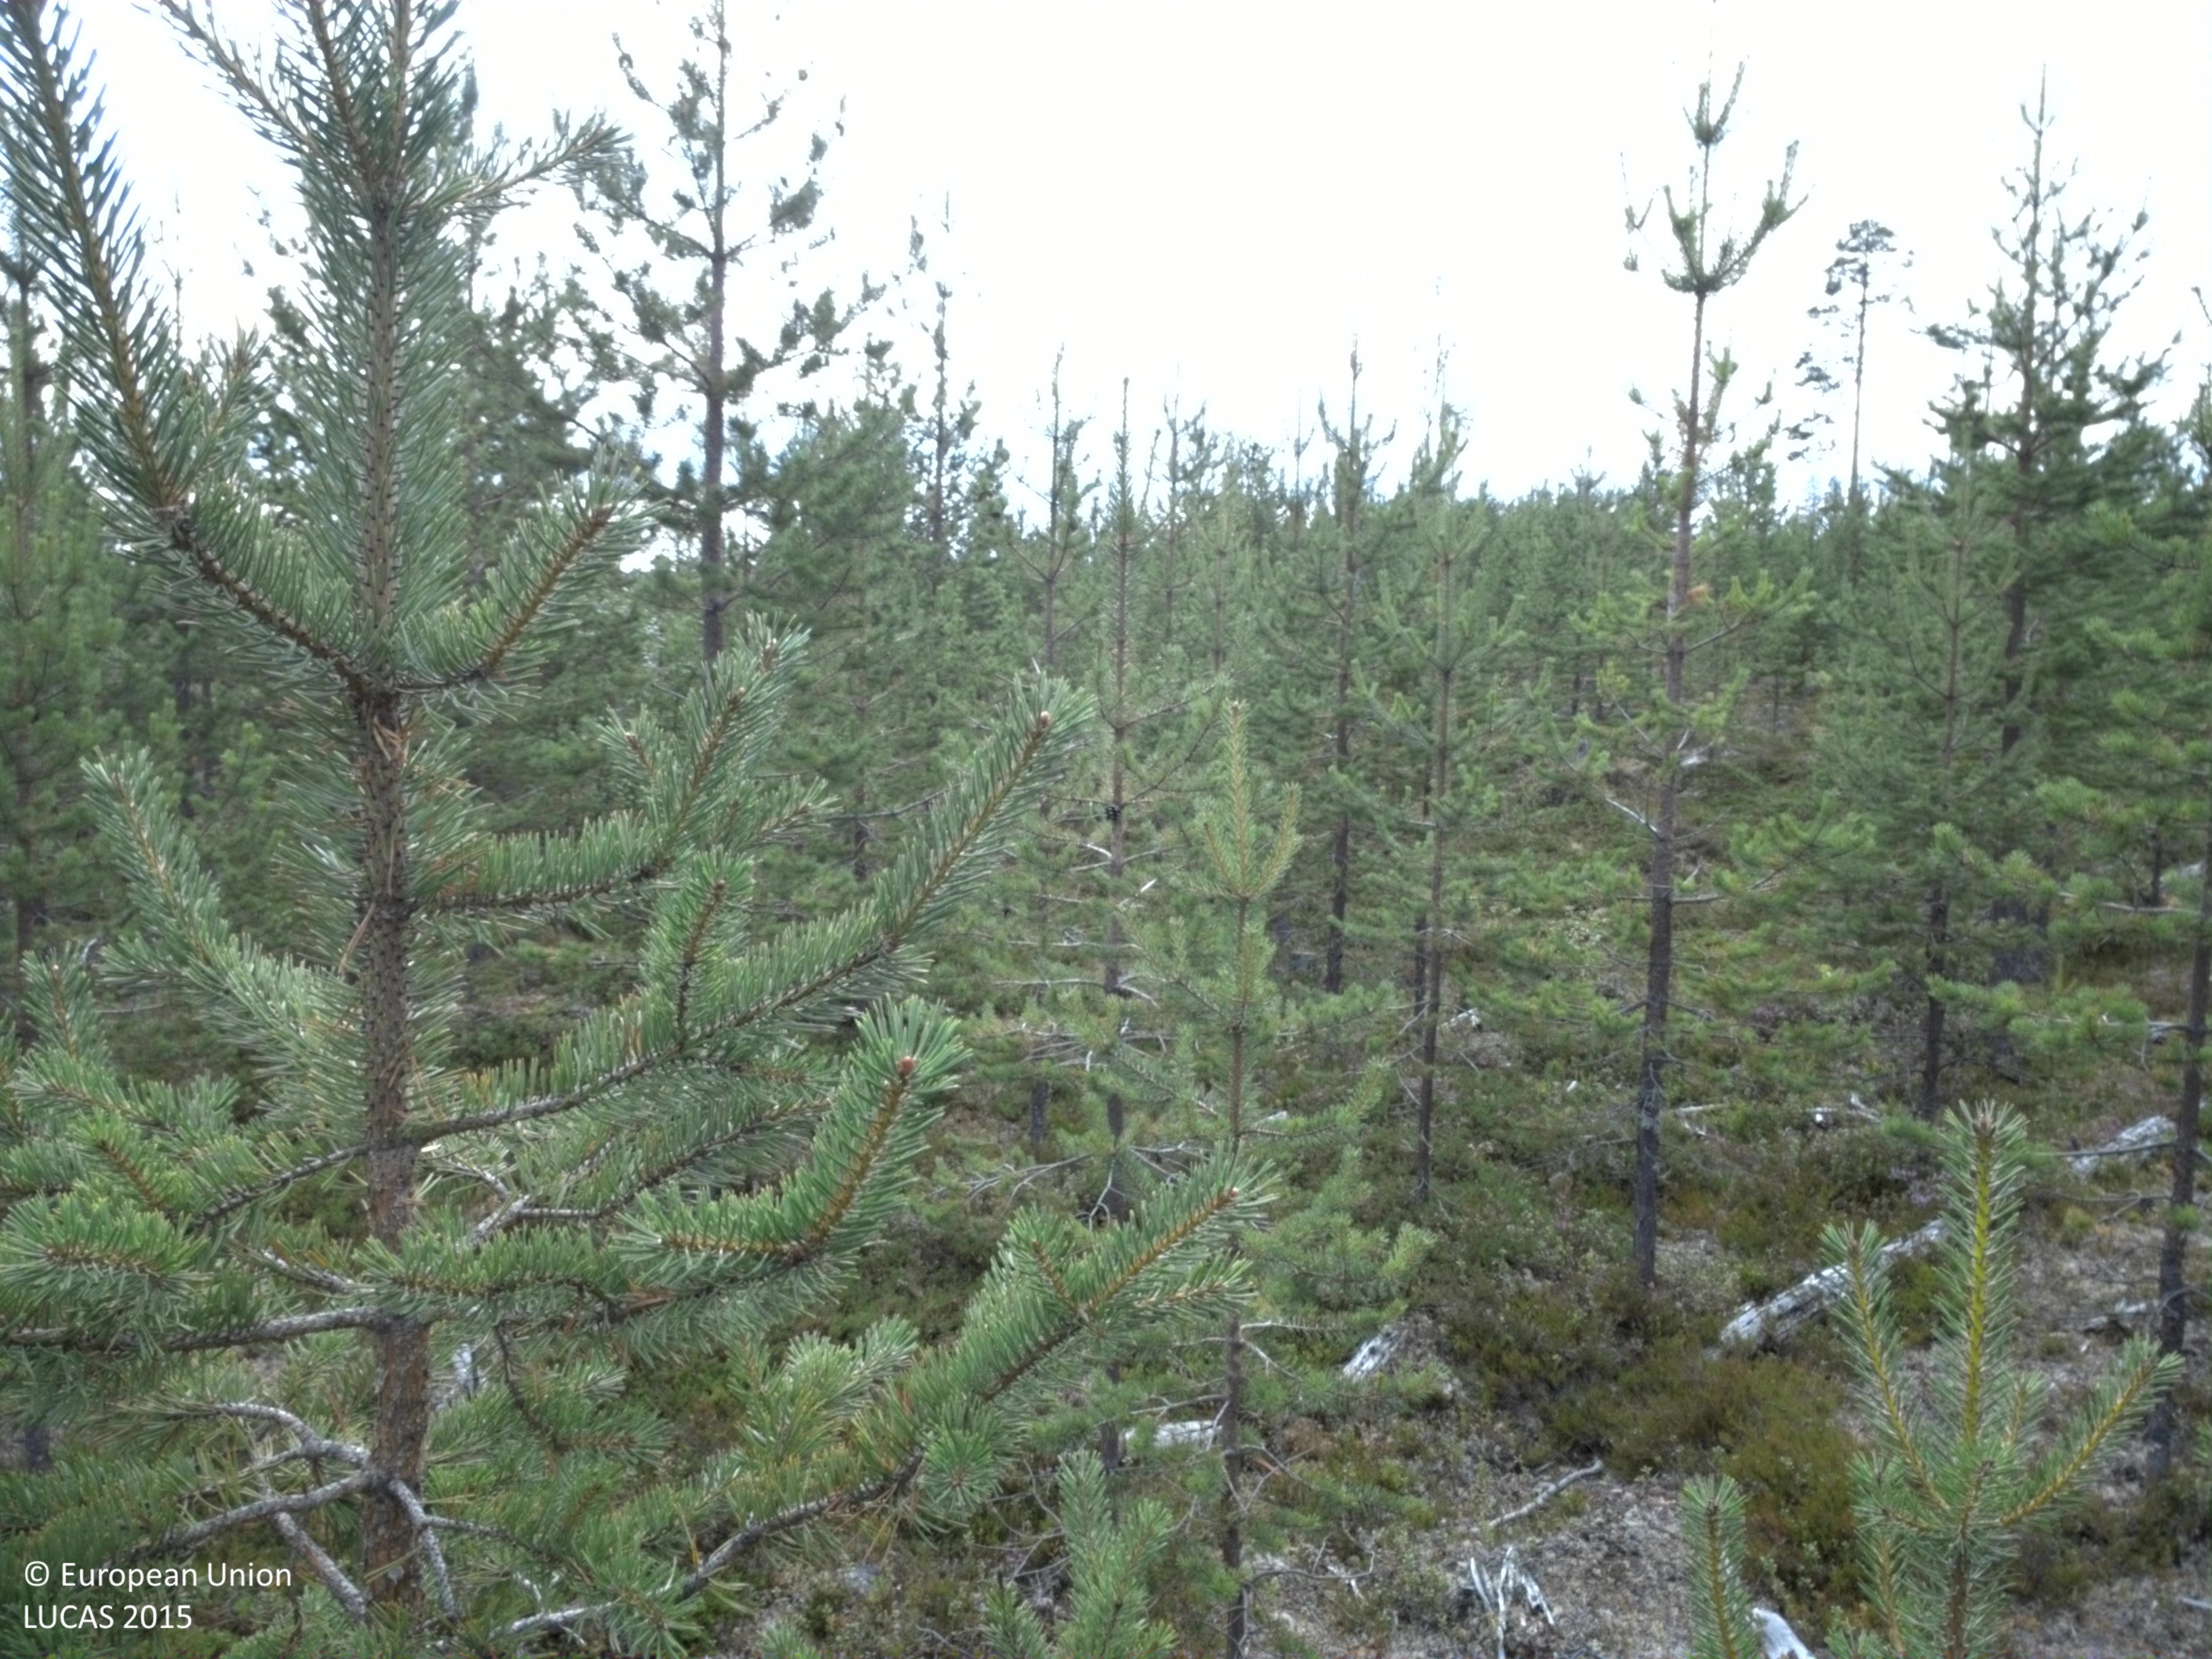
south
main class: Woodland
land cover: Pine dominated coniferous woodland
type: boreal forest
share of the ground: 25 - 50 %
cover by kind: shrubs 55 %, coniferous forest trees 30 %, lichens and mosses 15 %
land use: Forestry
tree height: > 5 m
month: August
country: SE
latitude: 66.3343
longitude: 20.4734
